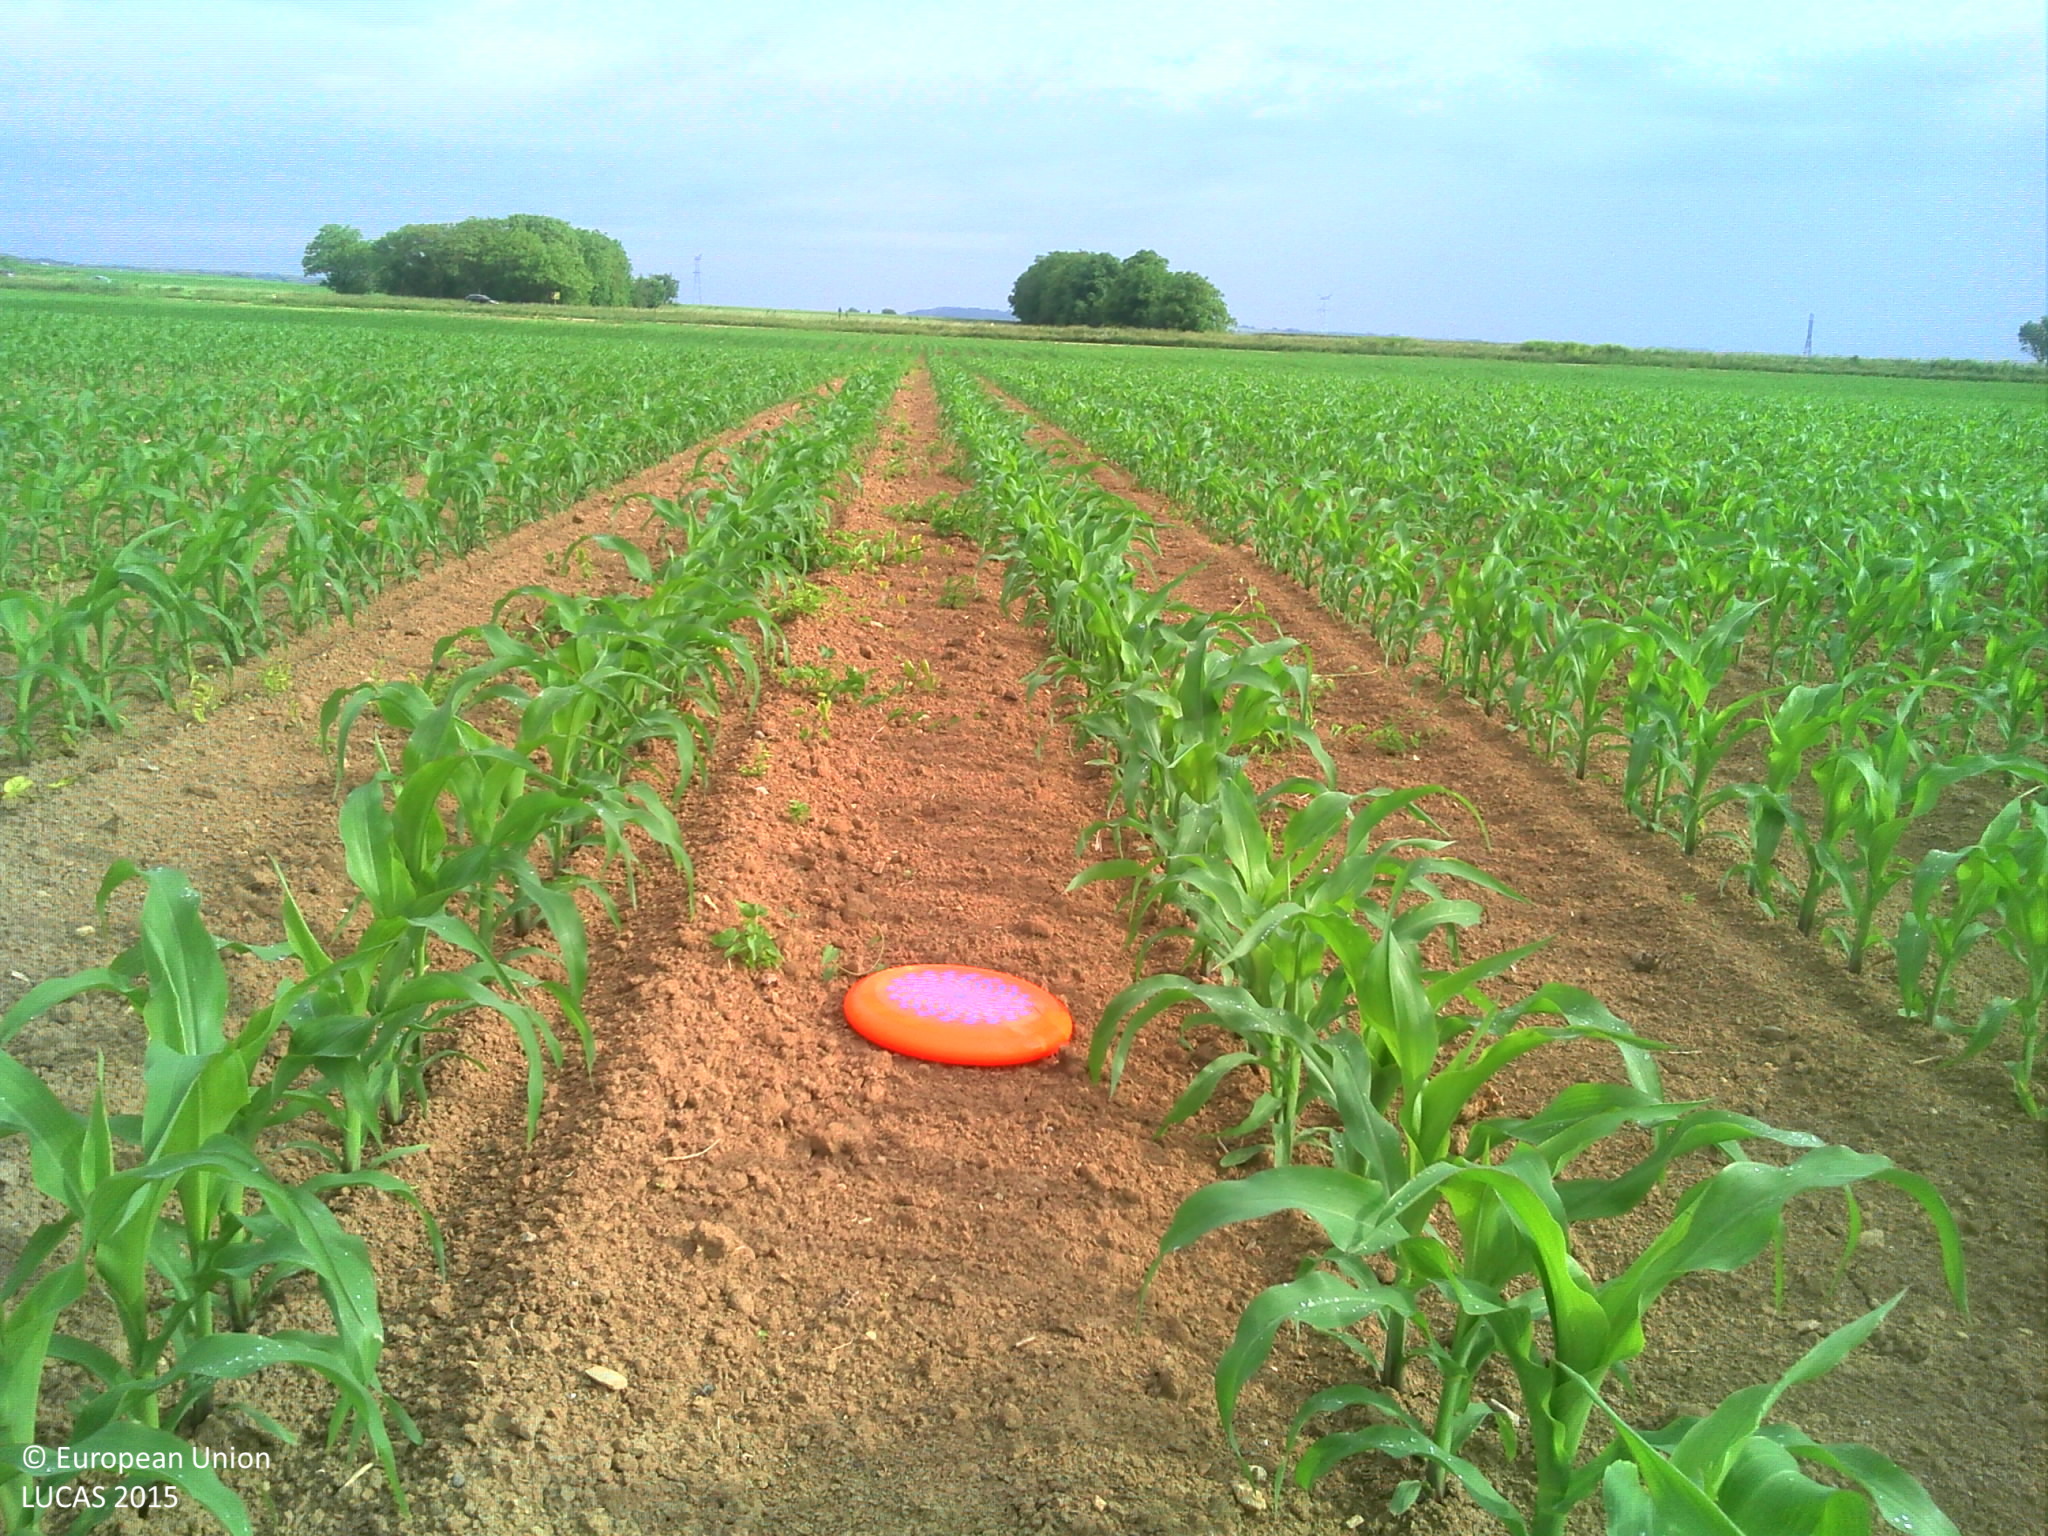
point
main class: Cropland
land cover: Maize
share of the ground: 10 - 25 %
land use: Agriculture (excluding fallow land and kitchen gardens)
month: May
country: FR
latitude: 48.6103
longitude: 7.5459
